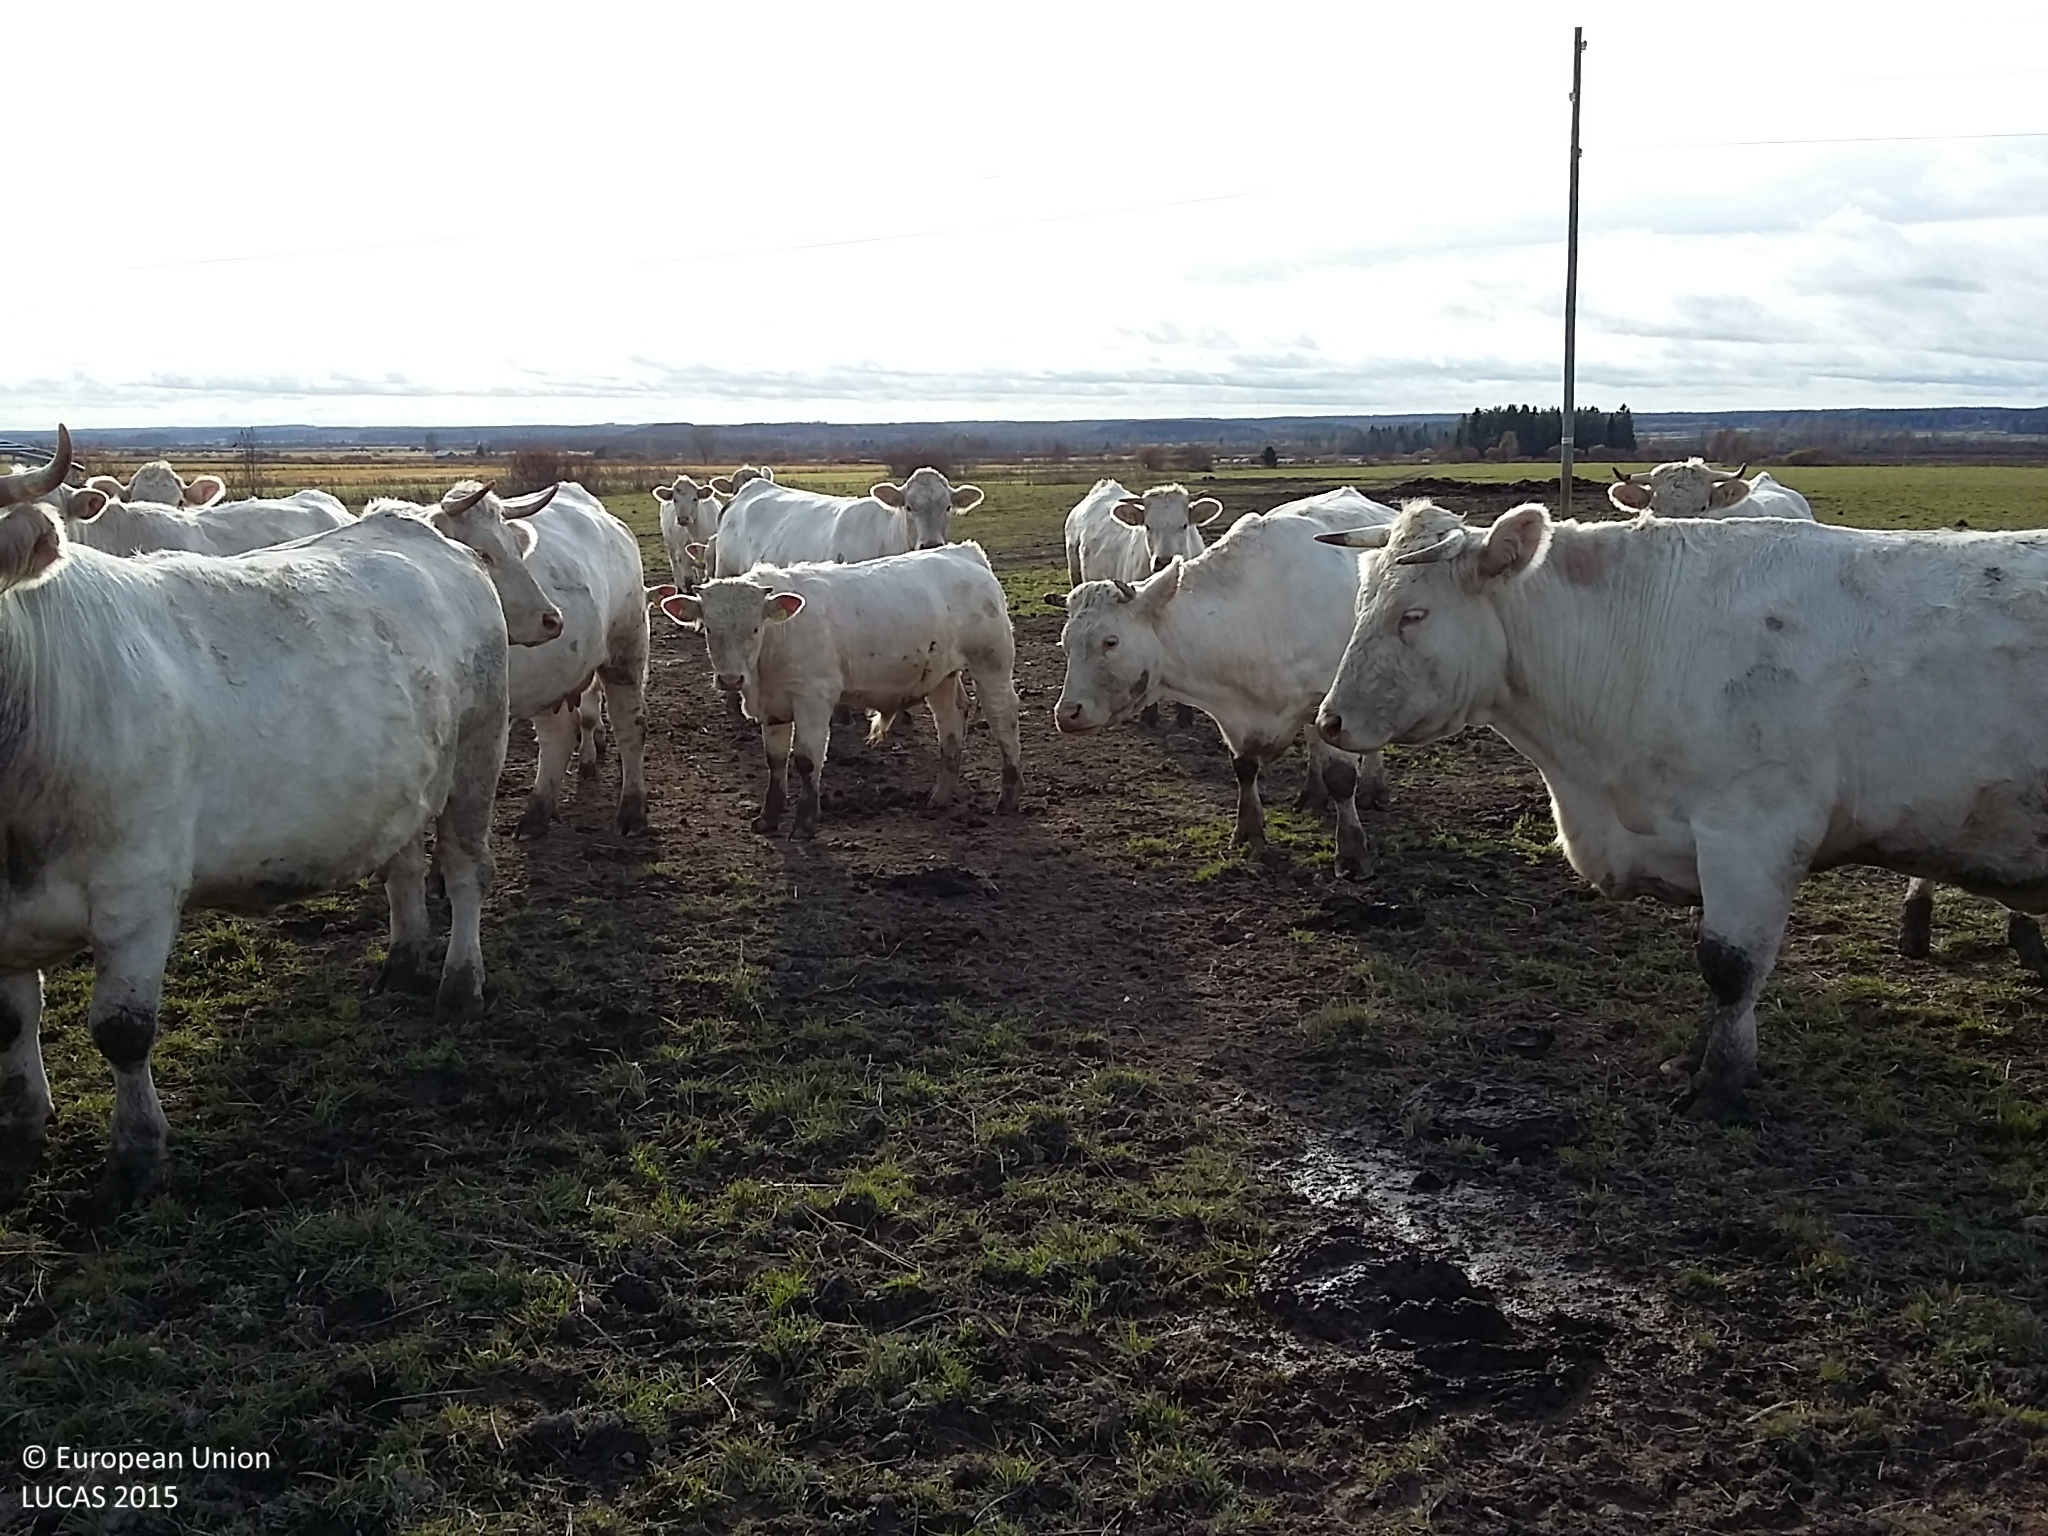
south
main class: Grassland
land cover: Grassland without tree/shrub cover
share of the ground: > 75 %
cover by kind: herbaceous plants 100 %
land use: Agriculture (excluding fallow land and kitchen gardens)
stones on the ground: < 10 %
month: October
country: FI
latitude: 63.8776
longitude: 25.0495
